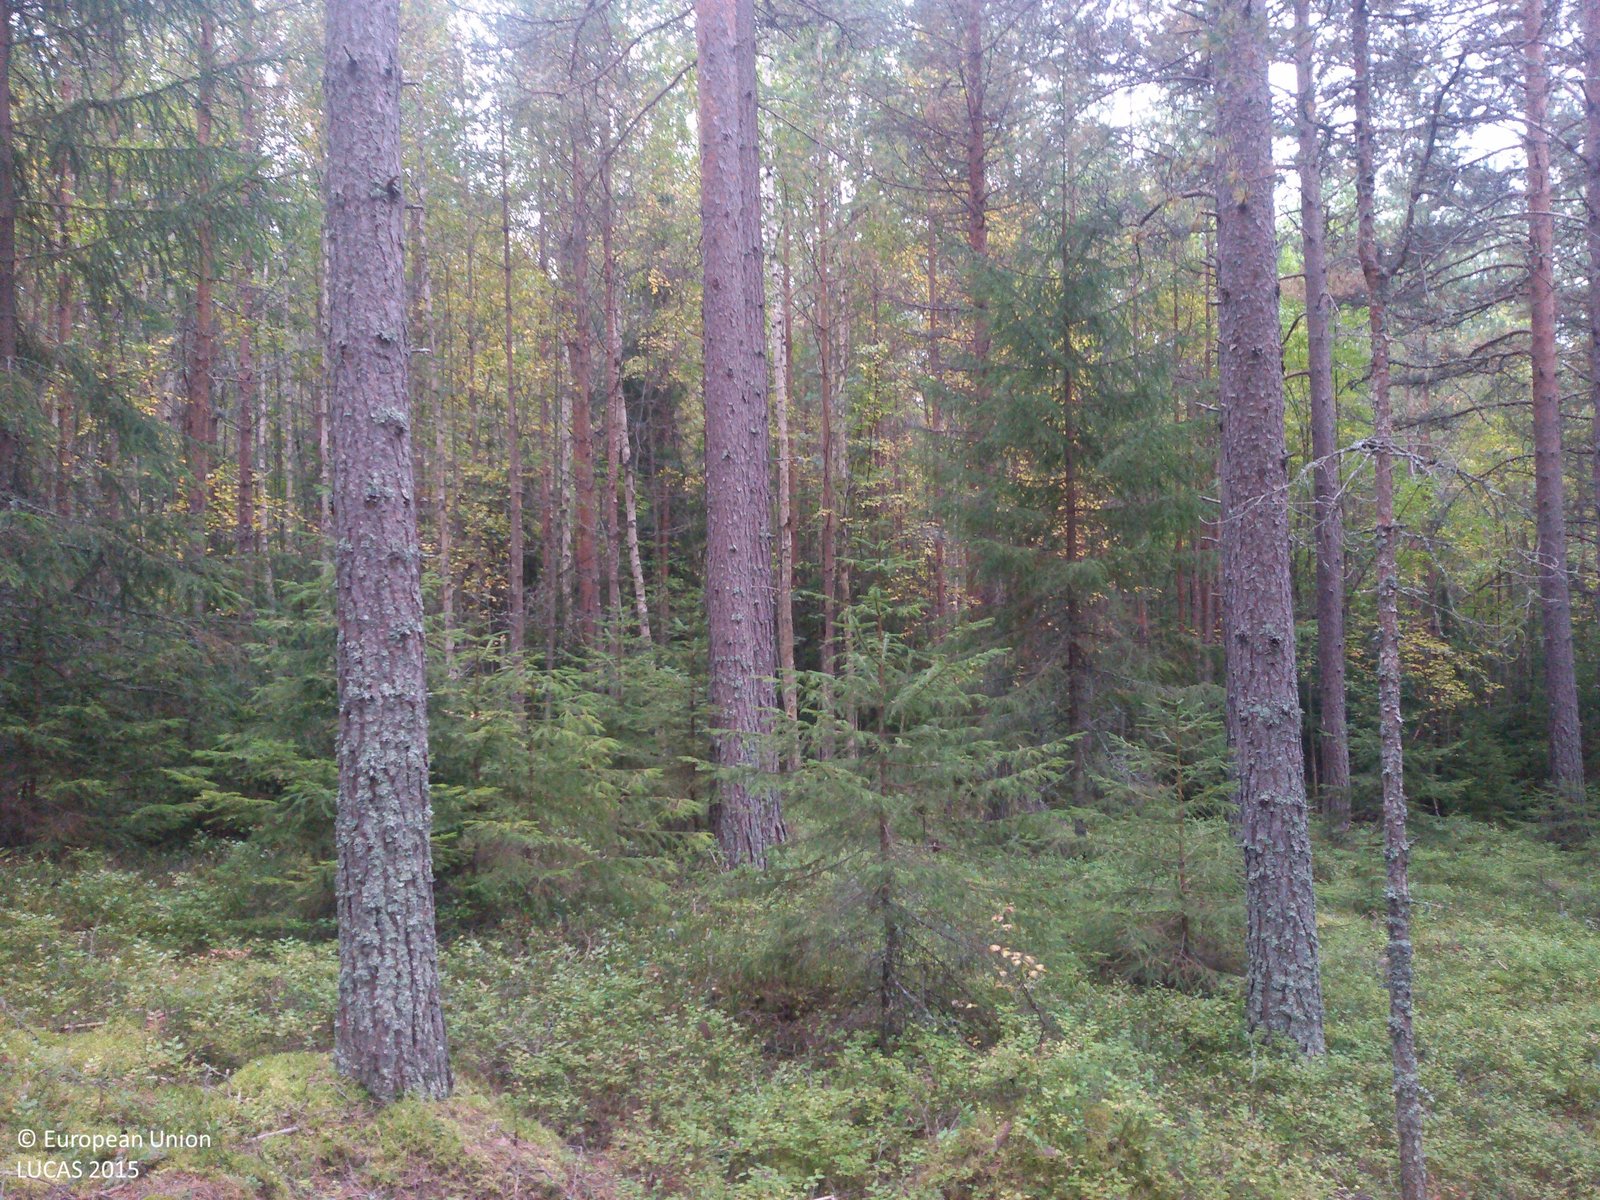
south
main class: Woodland
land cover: Pine dominated coniferous woodland
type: boreal forest
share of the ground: > 75 %
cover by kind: coniferous forest trees 75 %, shrubs 15 %, lichens and mosses 10 %
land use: Forestry
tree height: > 5 m
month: September
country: SE
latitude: 61.0709
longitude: 14.3047
